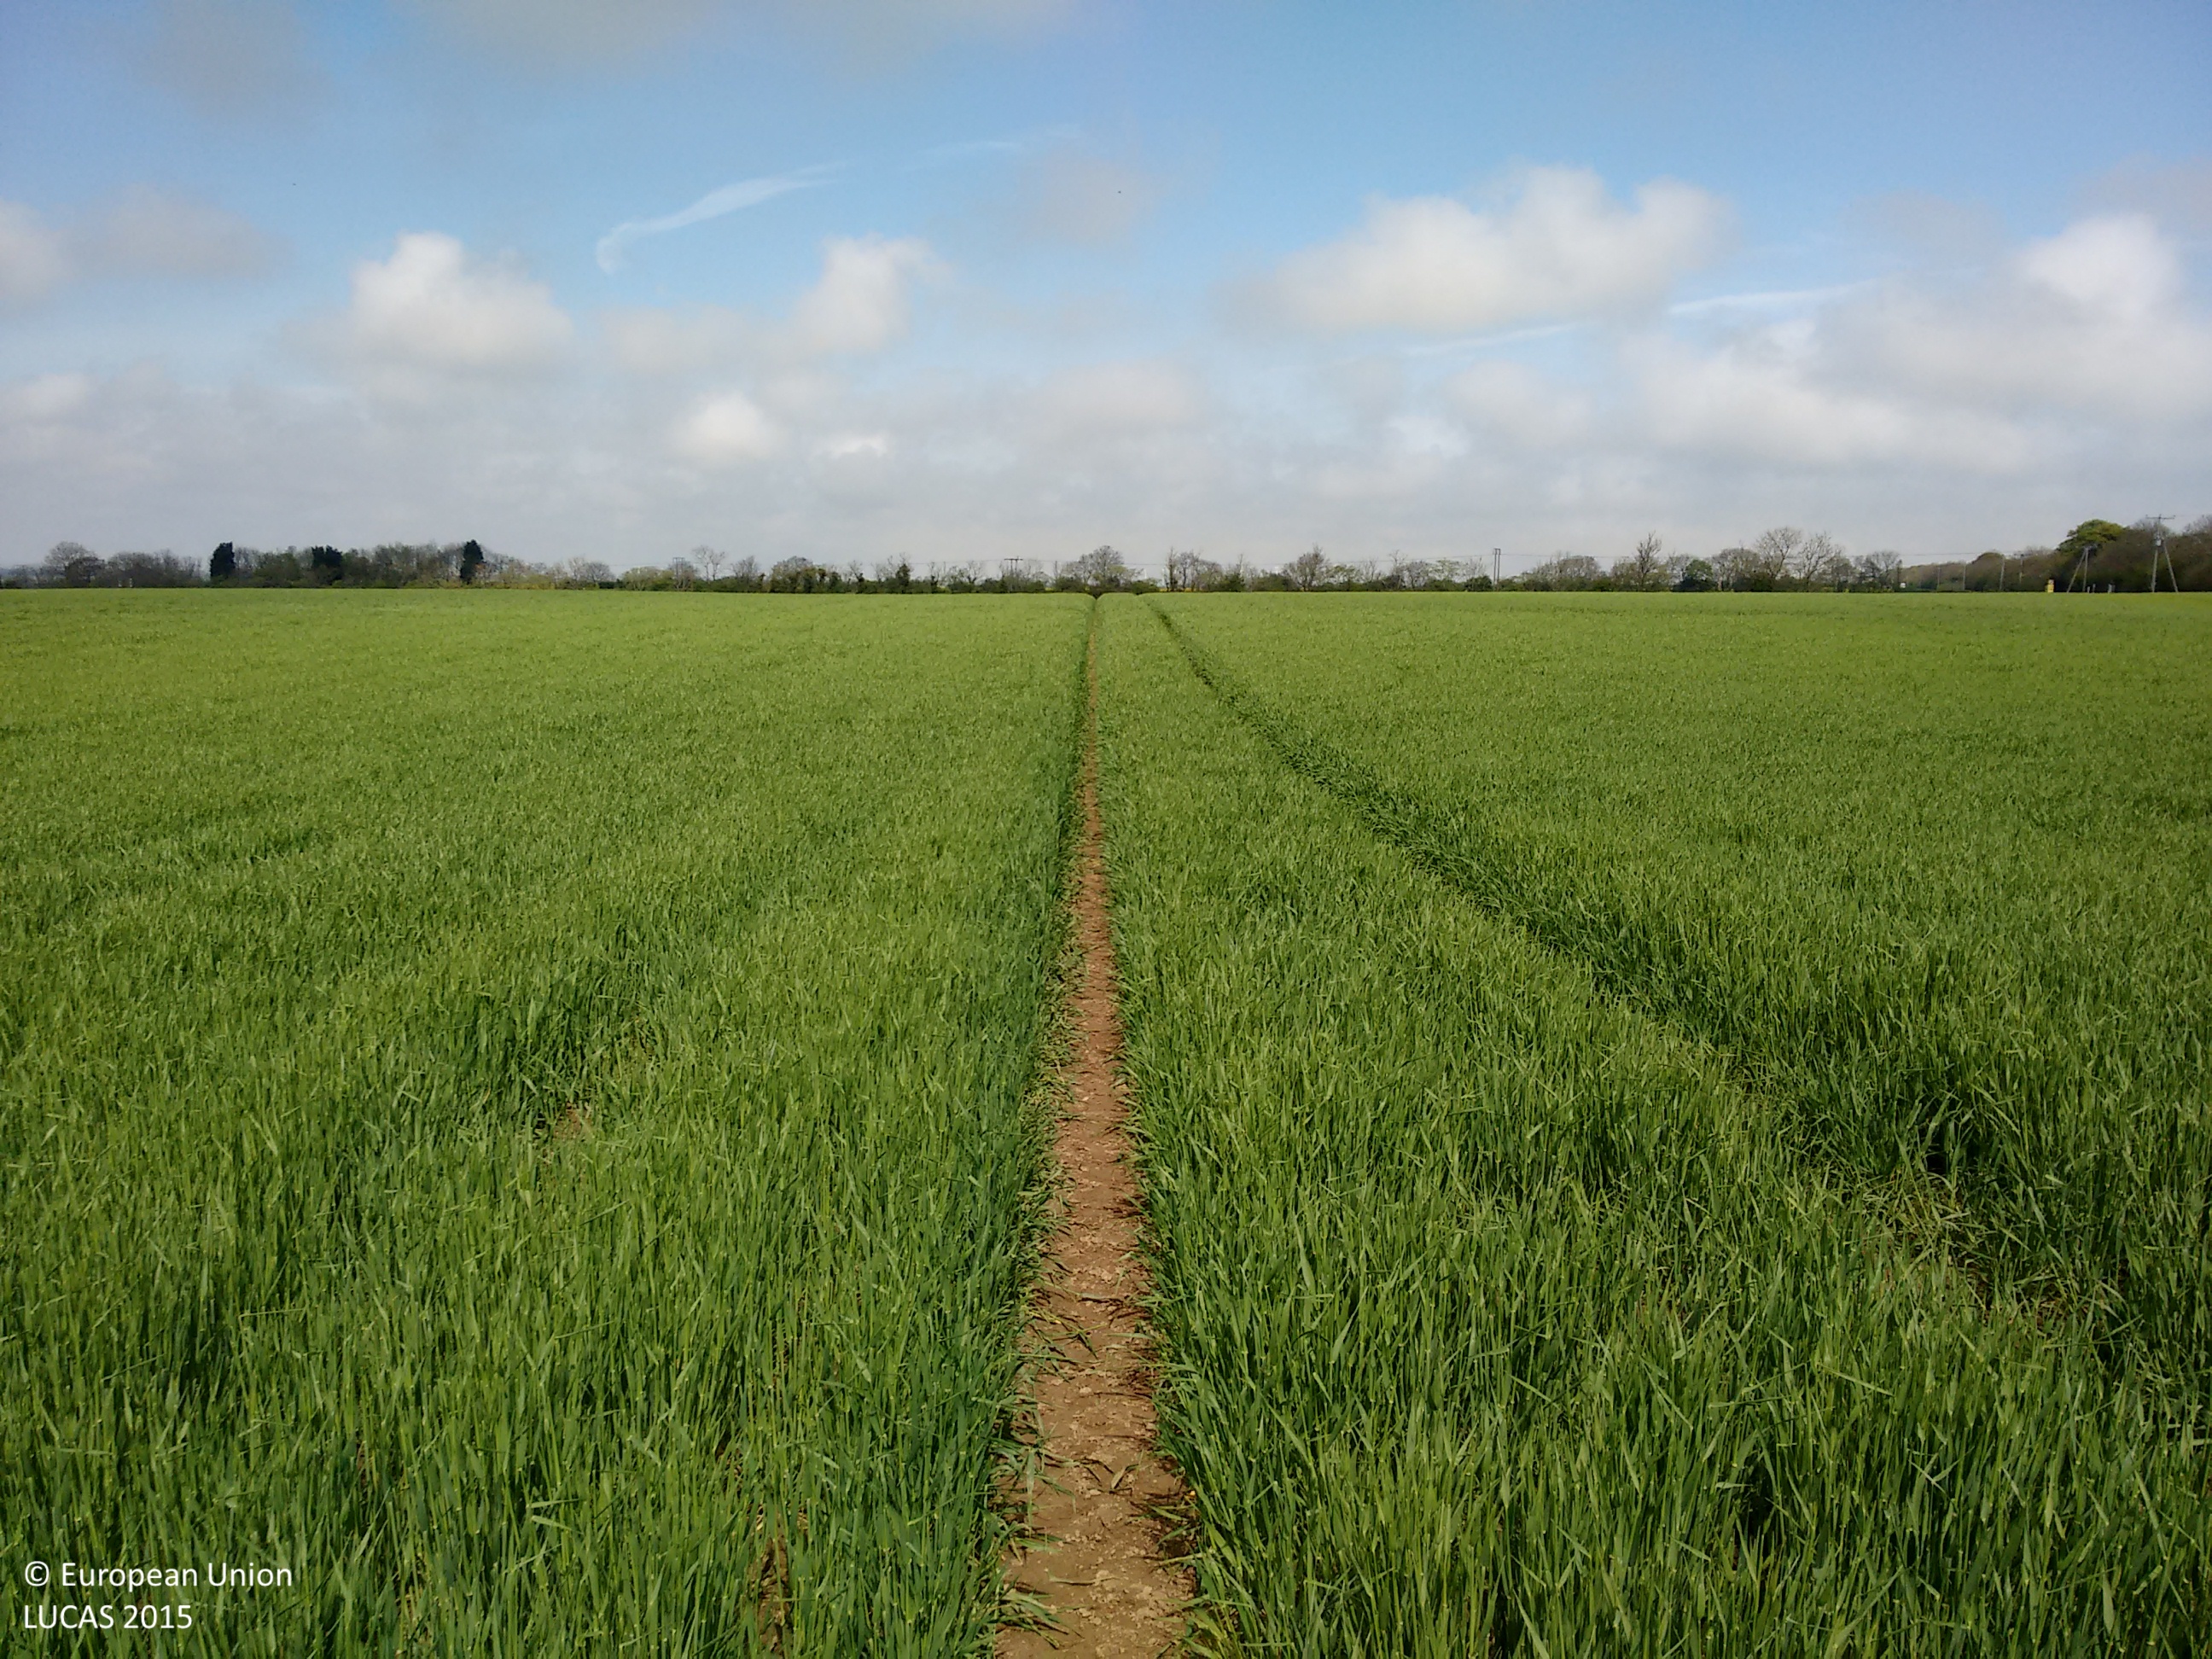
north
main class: Cropland
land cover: Barley
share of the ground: > 75 %
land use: Agriculture (excluding fallow land and kitchen gardens)
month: May
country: GB
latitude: 53.9417
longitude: -0.2869
